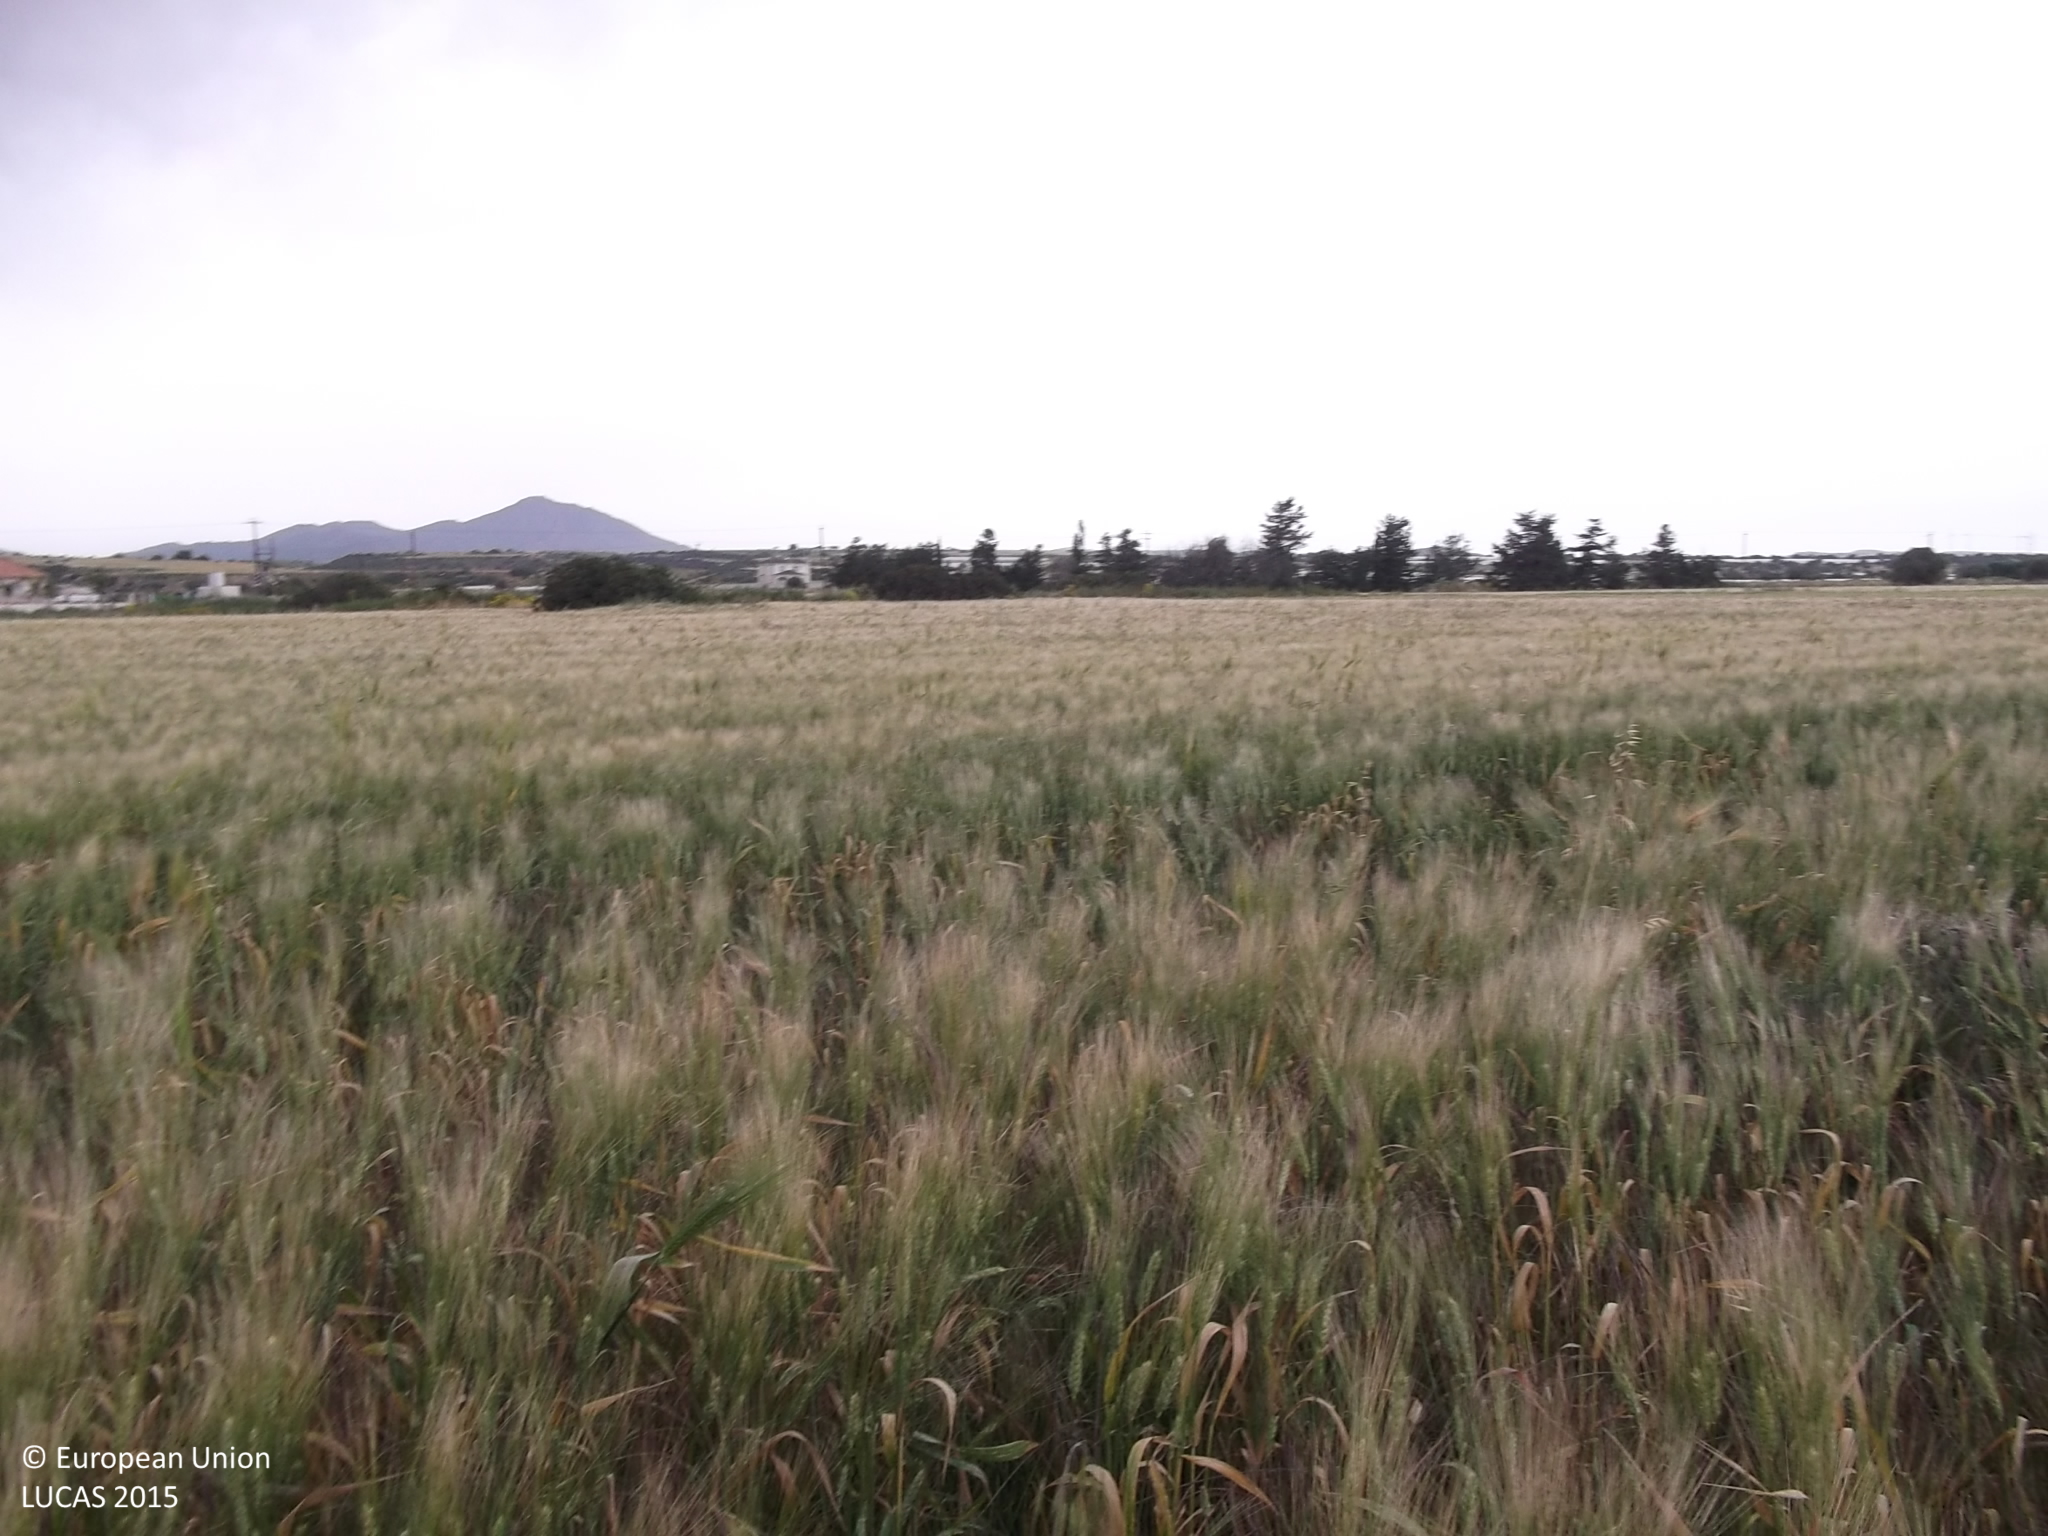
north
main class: Cropland
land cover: Mixed cereals for fodder
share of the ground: > 75 %
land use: Agriculture (excluding fallow land and kitchen gardens)
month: April
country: CY
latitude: 34.7842
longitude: 33.4733
